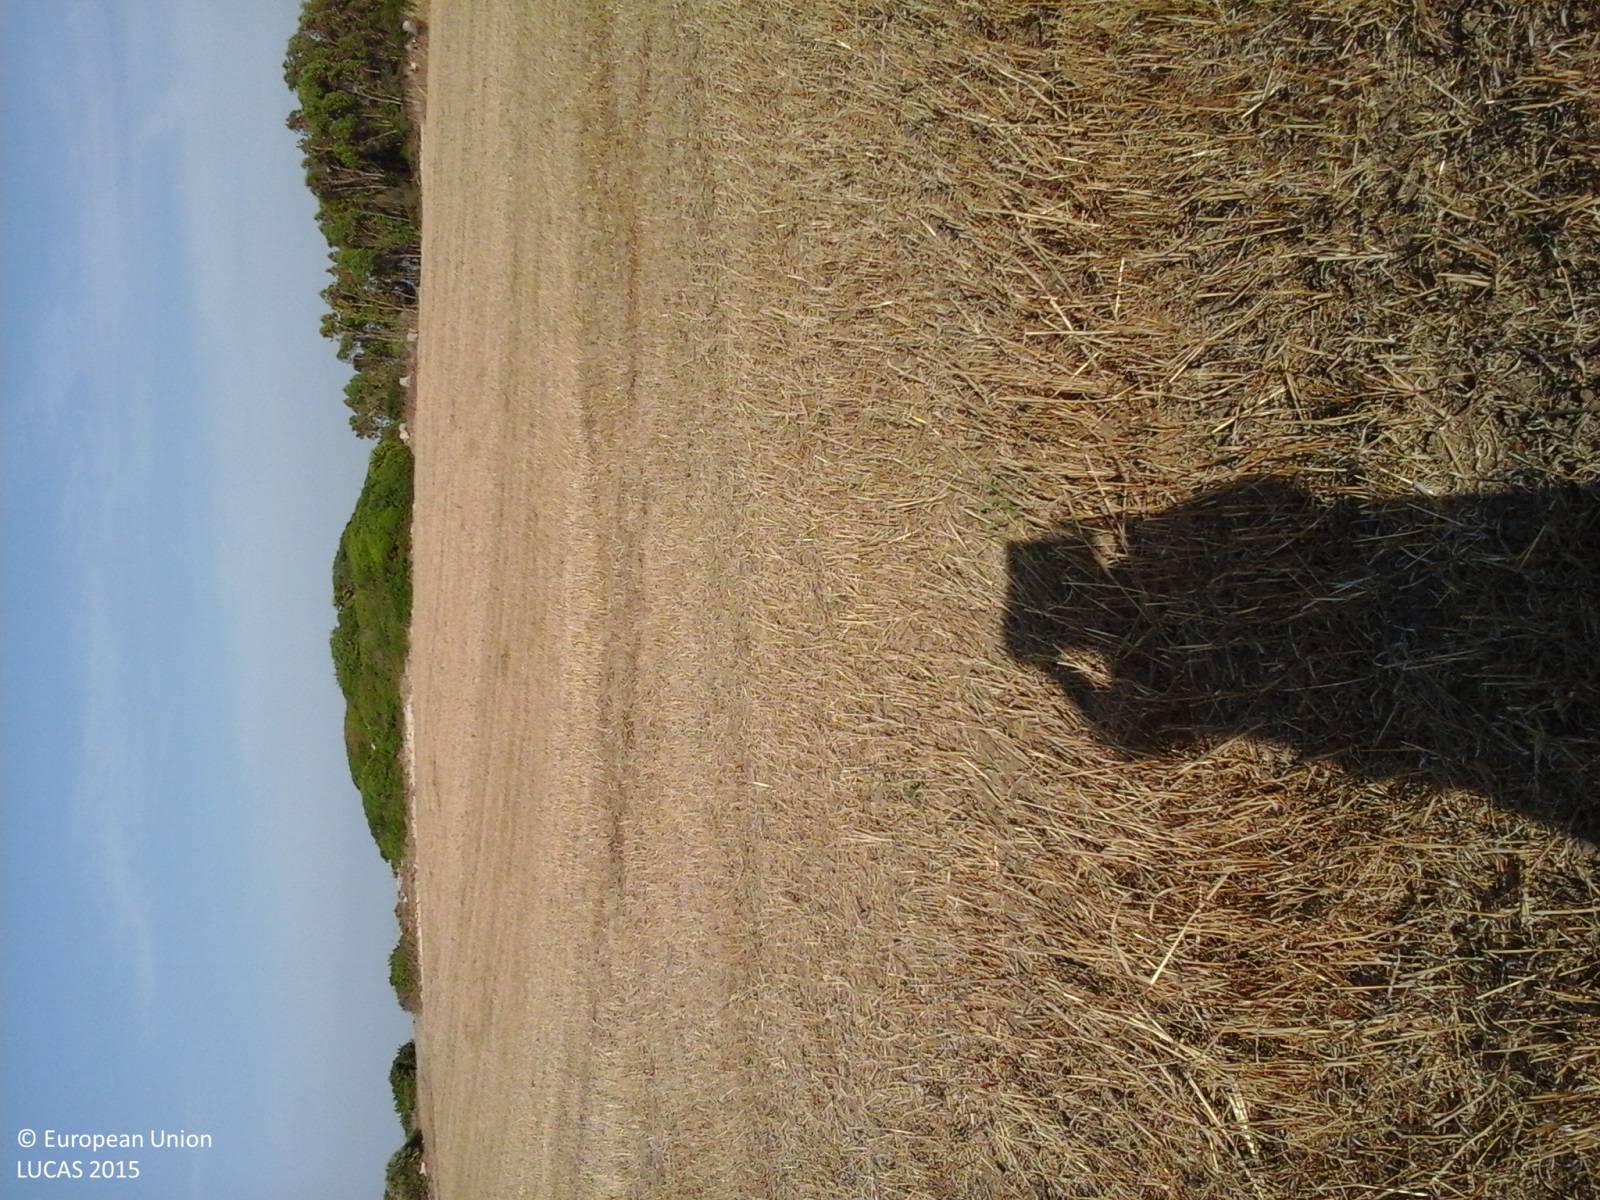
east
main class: Cropland
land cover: Barley
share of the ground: < 10 %
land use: Agriculture (excluding fallow land and kitchen gardens)
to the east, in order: Barley; Shrubland without tree cover; Fences; Dry stone walls; Tracks; Grassland without tree/shrub cover; Shrubland without tree cover; Grassland without tree/shrub cover; Shrubland without tree cover; Electric lines; Shrubland without tree cover
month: August
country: IT
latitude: 40.0197
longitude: 8.4501
